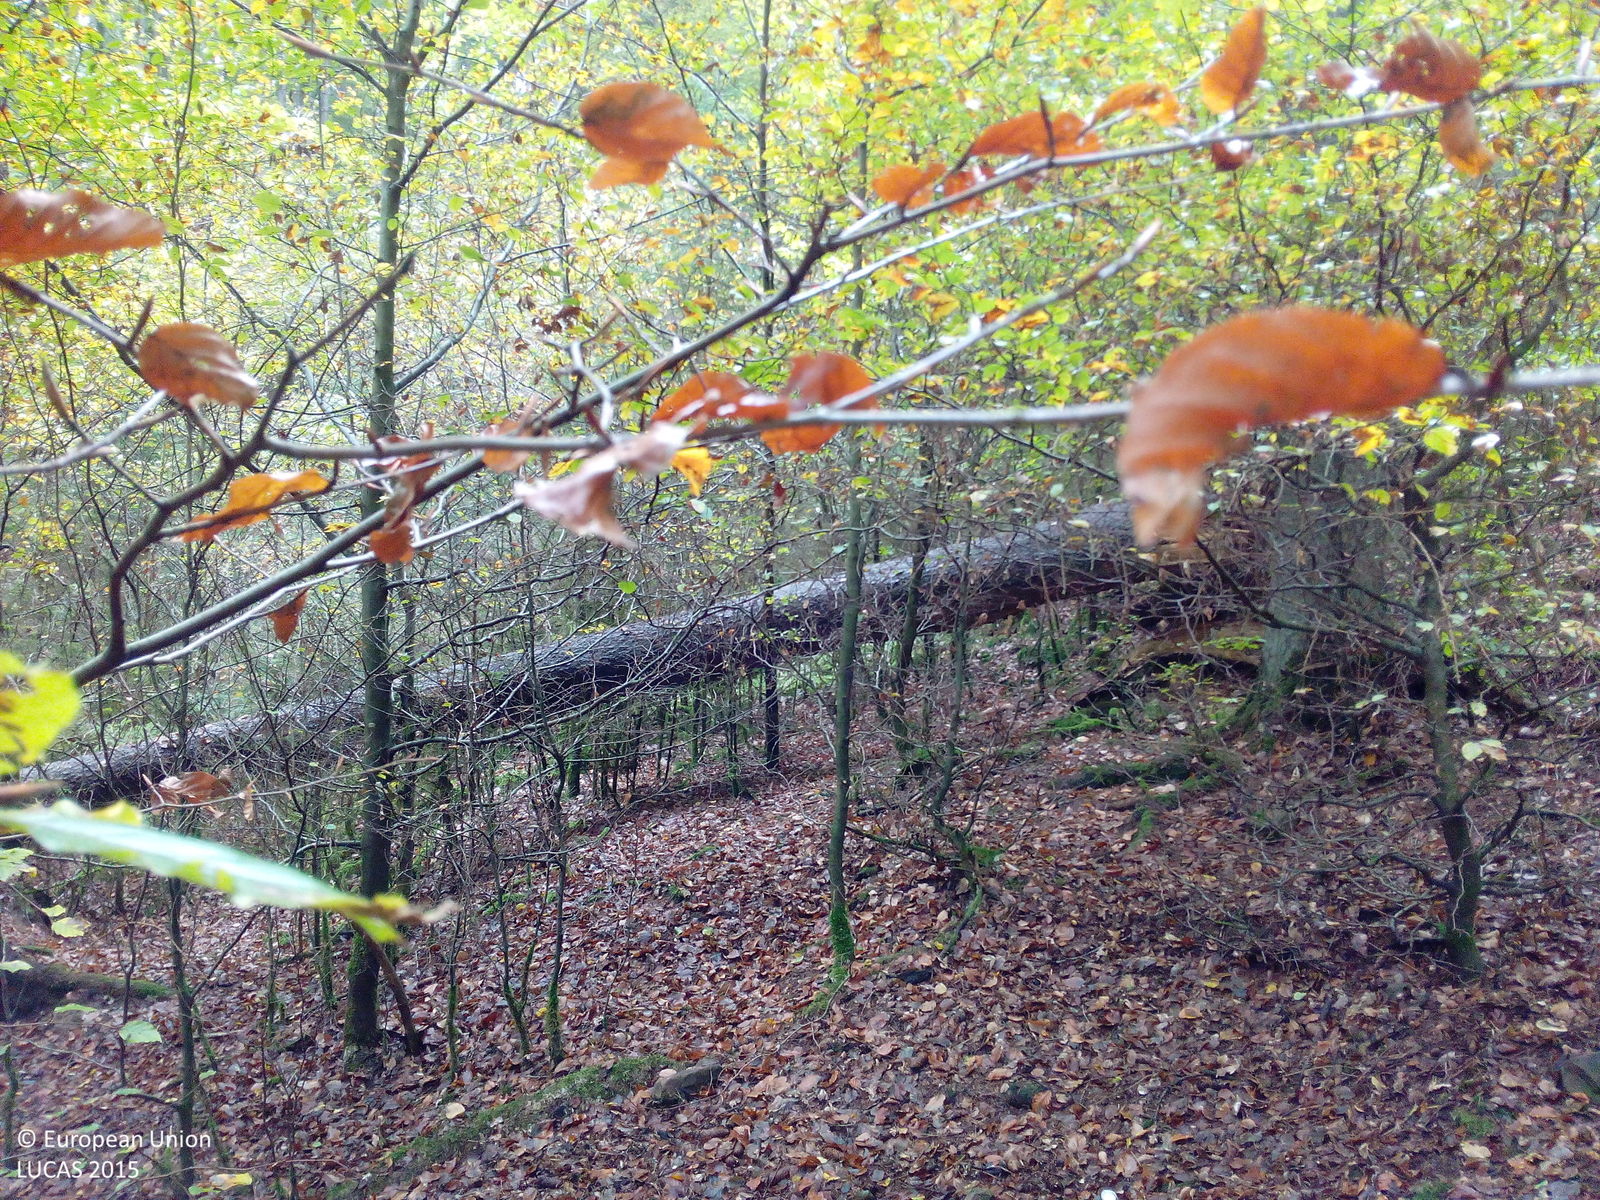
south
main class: Woodland
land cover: Spruce dominated mixed woodland
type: hemiboreal forest and nemoral coniferous forest and mixed broadleaved-coniferous forest
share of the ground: 50 - 75 %
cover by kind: broadleaved forest trees 40 %, coniferous forest trees 25 %, lichens and mosses 15 %, unconsolidated bare surface 10 %, shrubs 5 %, herbaceous plants 5 %
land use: Forestry
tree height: > 5 m
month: October
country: DE
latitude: 50.2554
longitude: 9.5934
